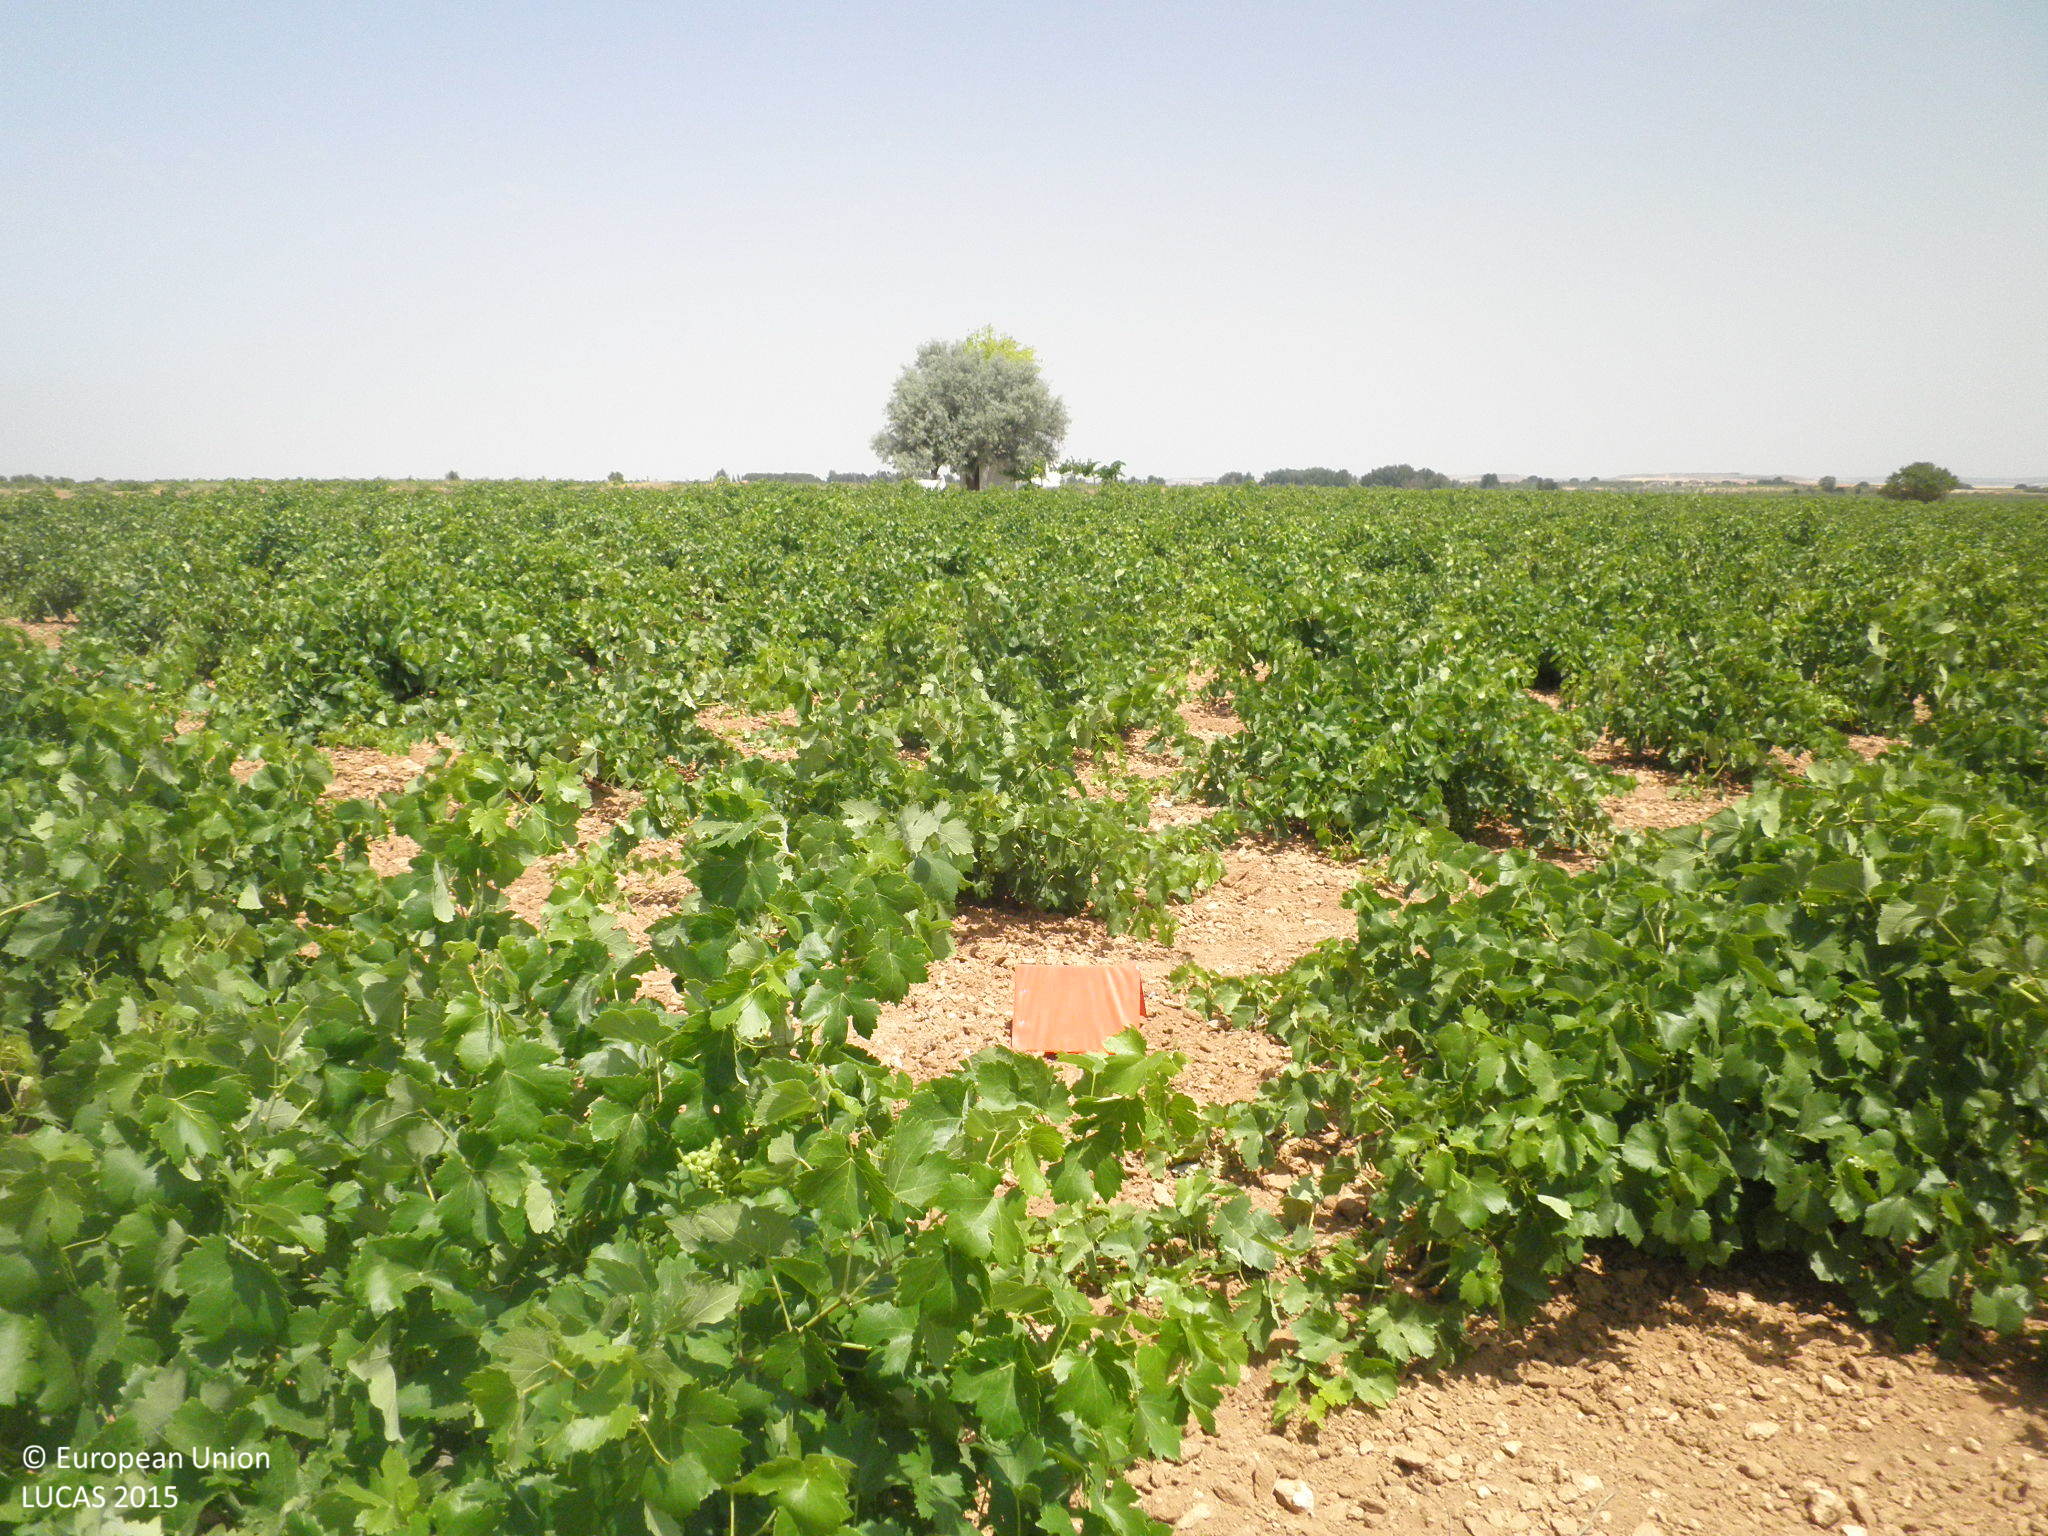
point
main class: Cropland
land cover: Vineyards
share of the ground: 25 - 50 %
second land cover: Other bare soil
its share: > 75 %
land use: Agriculture (excluding fallow land and kitchen gardens)
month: July
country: ES
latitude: 39.4990
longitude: -2.7950
